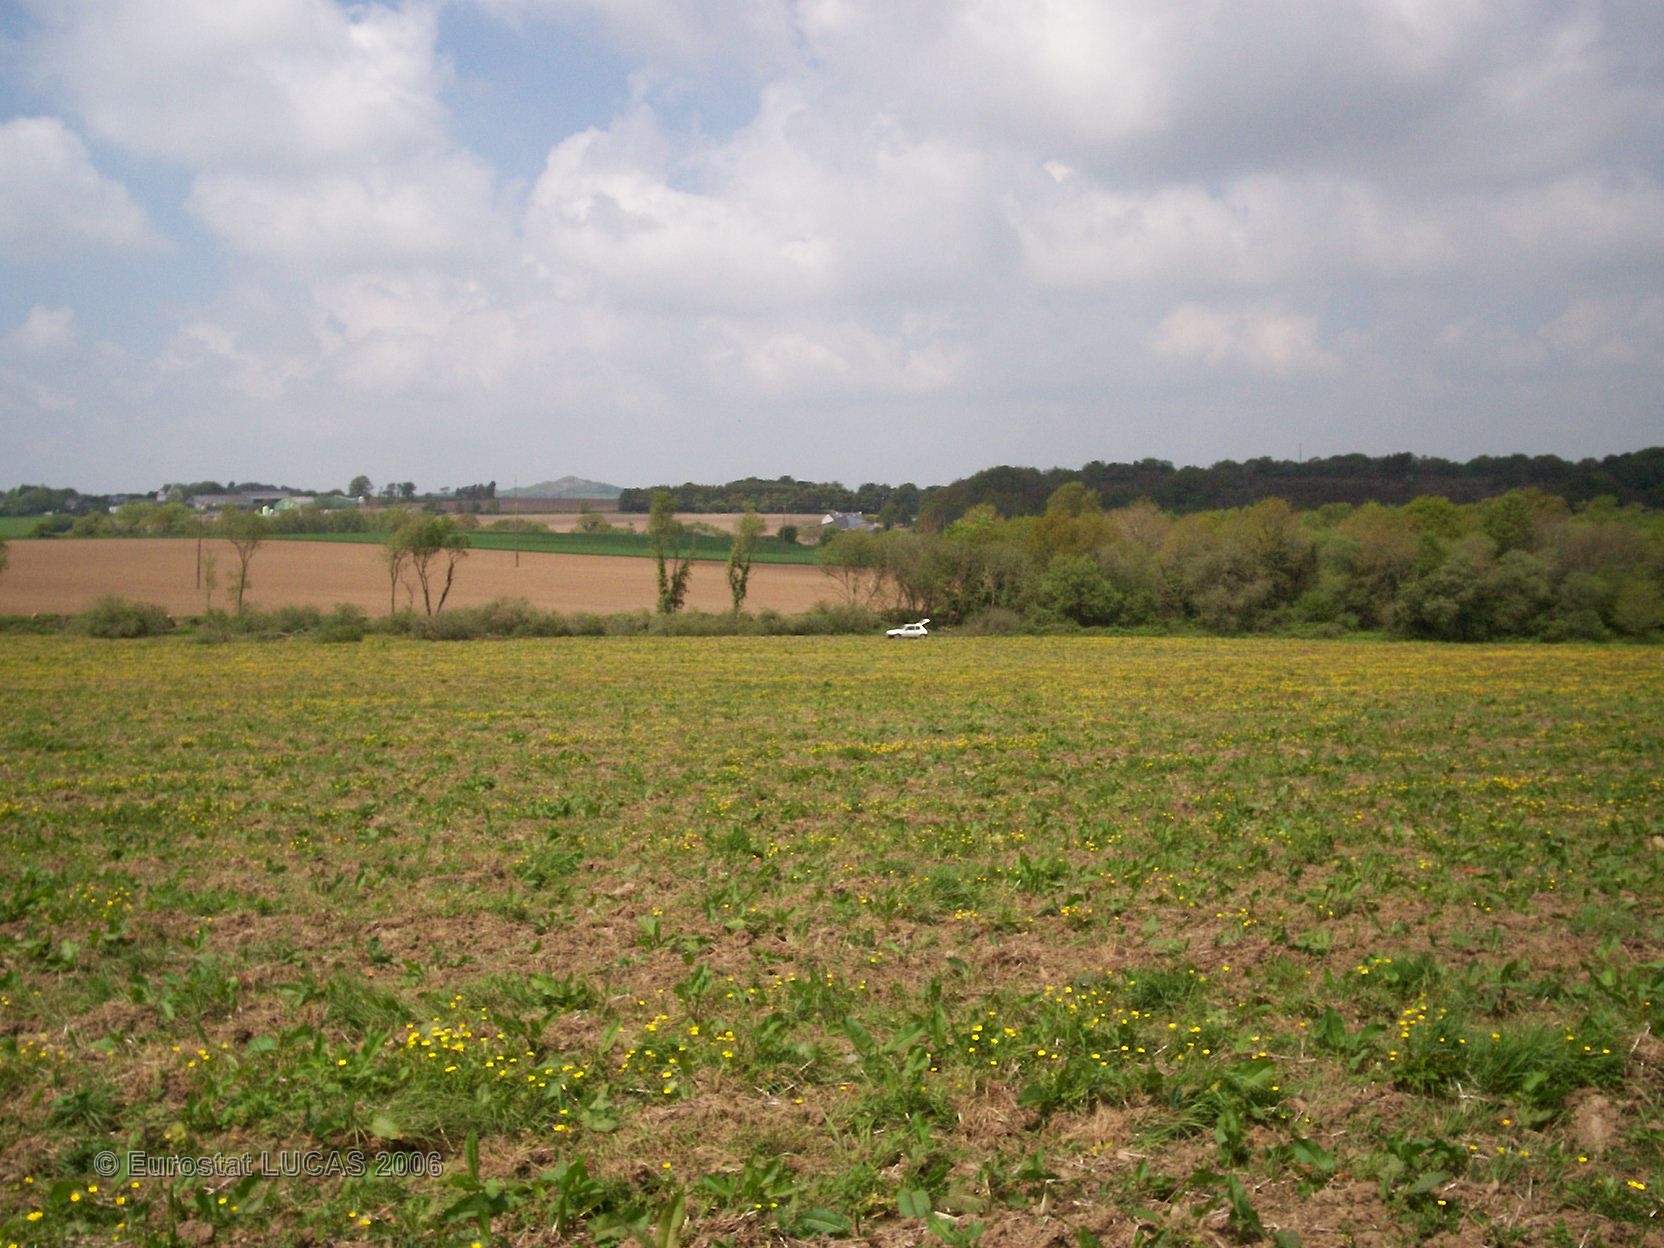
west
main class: Grassland
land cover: Grassland without tree/shrub cover
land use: Fallow land
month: May
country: FR
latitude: 48.1358
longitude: -3.9401
